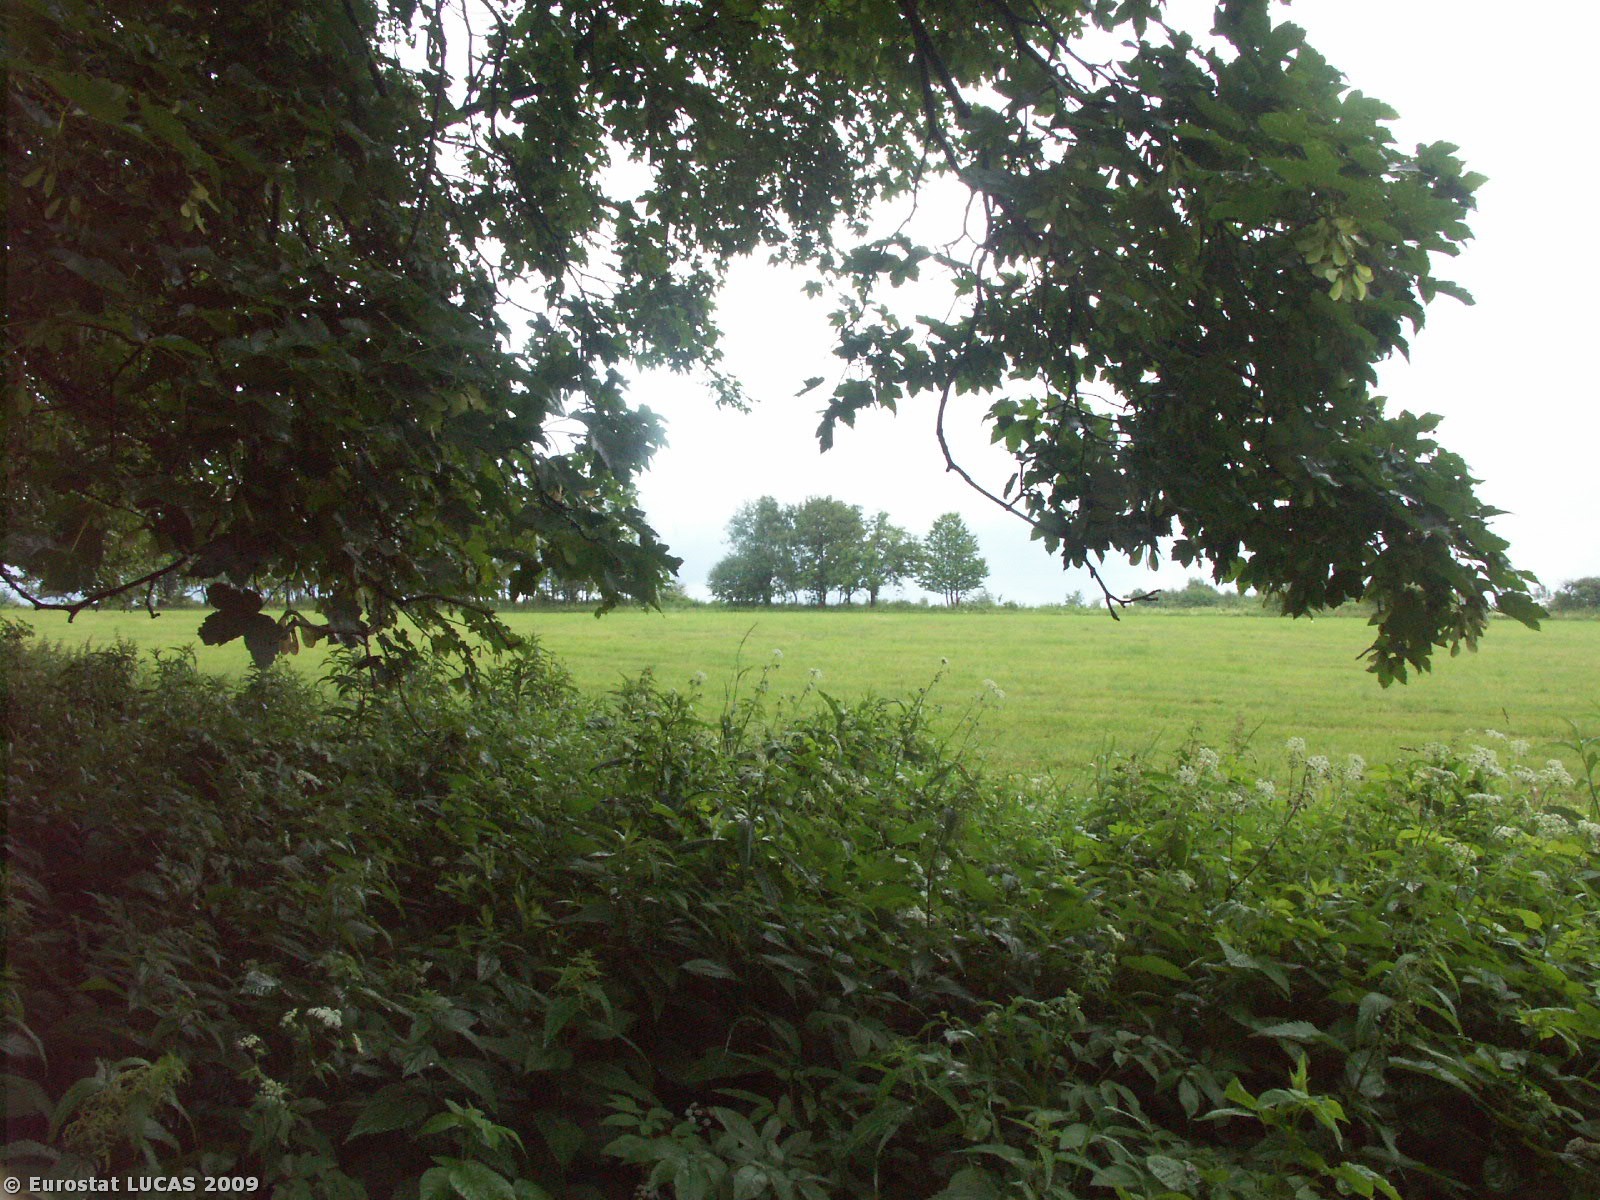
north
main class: Woodland
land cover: Broadleaved woodland
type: mesophytic deciduous forest
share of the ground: > 75 %
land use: Forestry
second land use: Nature reserves
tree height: > 5 m
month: July
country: CZ
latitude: 49.9197
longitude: 17.2115
